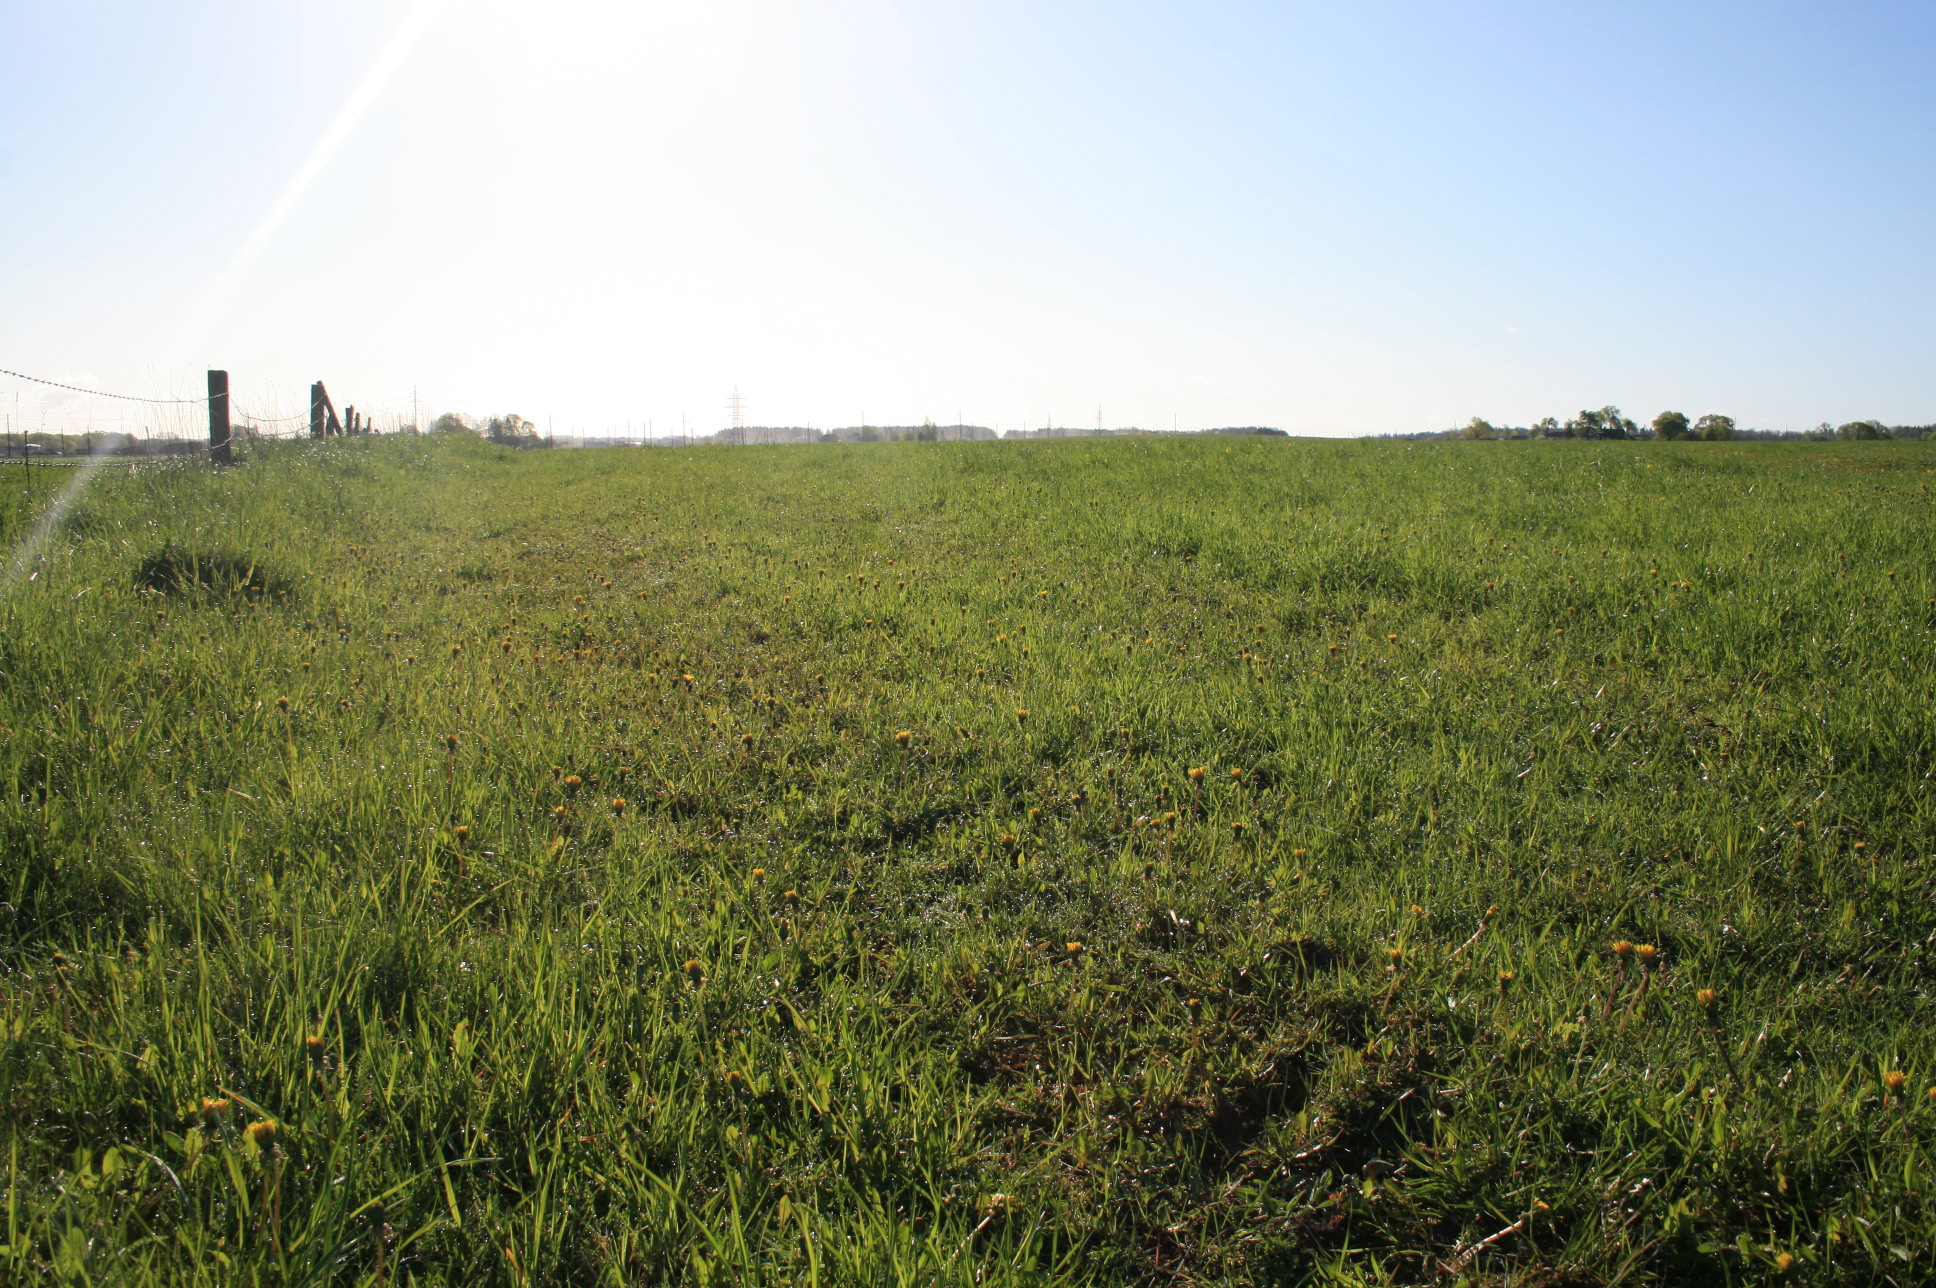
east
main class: Grassland
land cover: Grassland without tree/shrub cover
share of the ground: > 75 %
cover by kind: herbaceous plants 100 %
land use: Agriculture (excluding fallow land and kitchen gardens)
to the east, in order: Grassland without tree/shrub cover; Common wheat
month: May
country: LT
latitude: 56.2638
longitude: 21.5553
